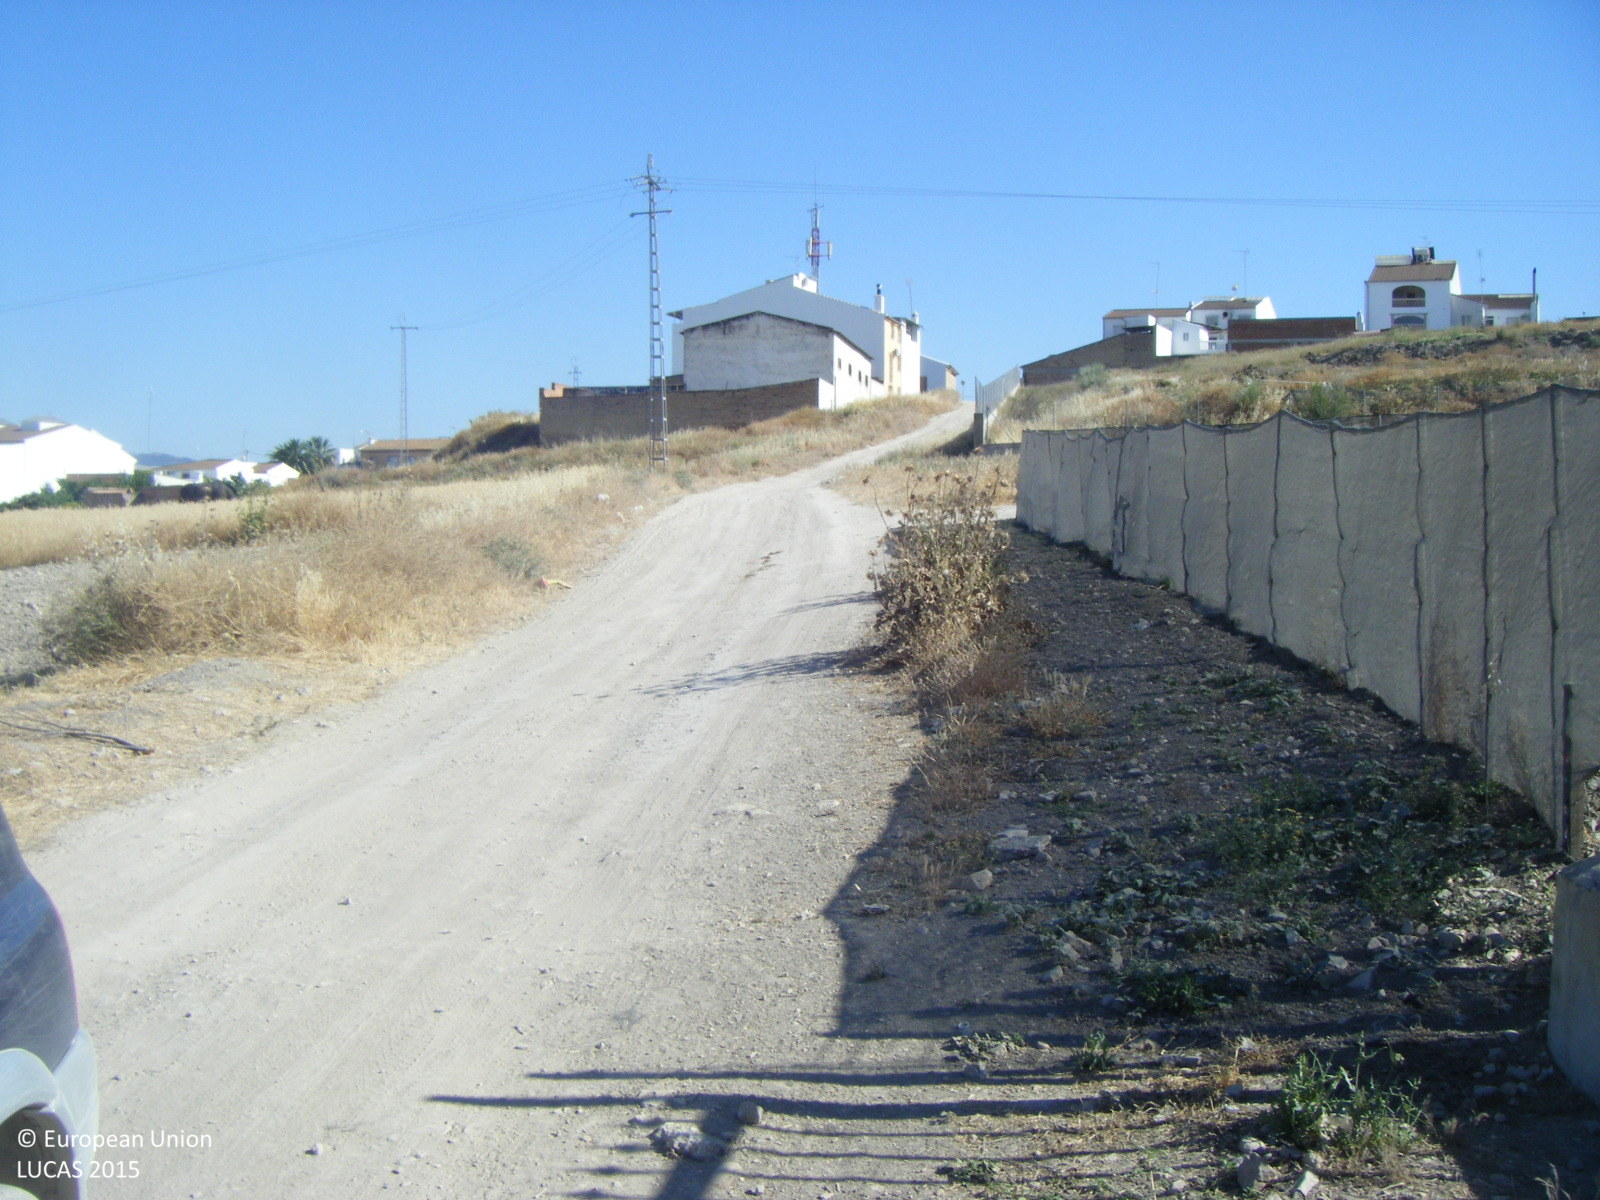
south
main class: Cropland
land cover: Olive groves
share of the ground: 10 - 25 %
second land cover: Other bare soil
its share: > 75 %
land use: Agriculture (excluding fallow land and kitchen gardens)
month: June
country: ES
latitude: 37.2678
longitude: -4.5364
